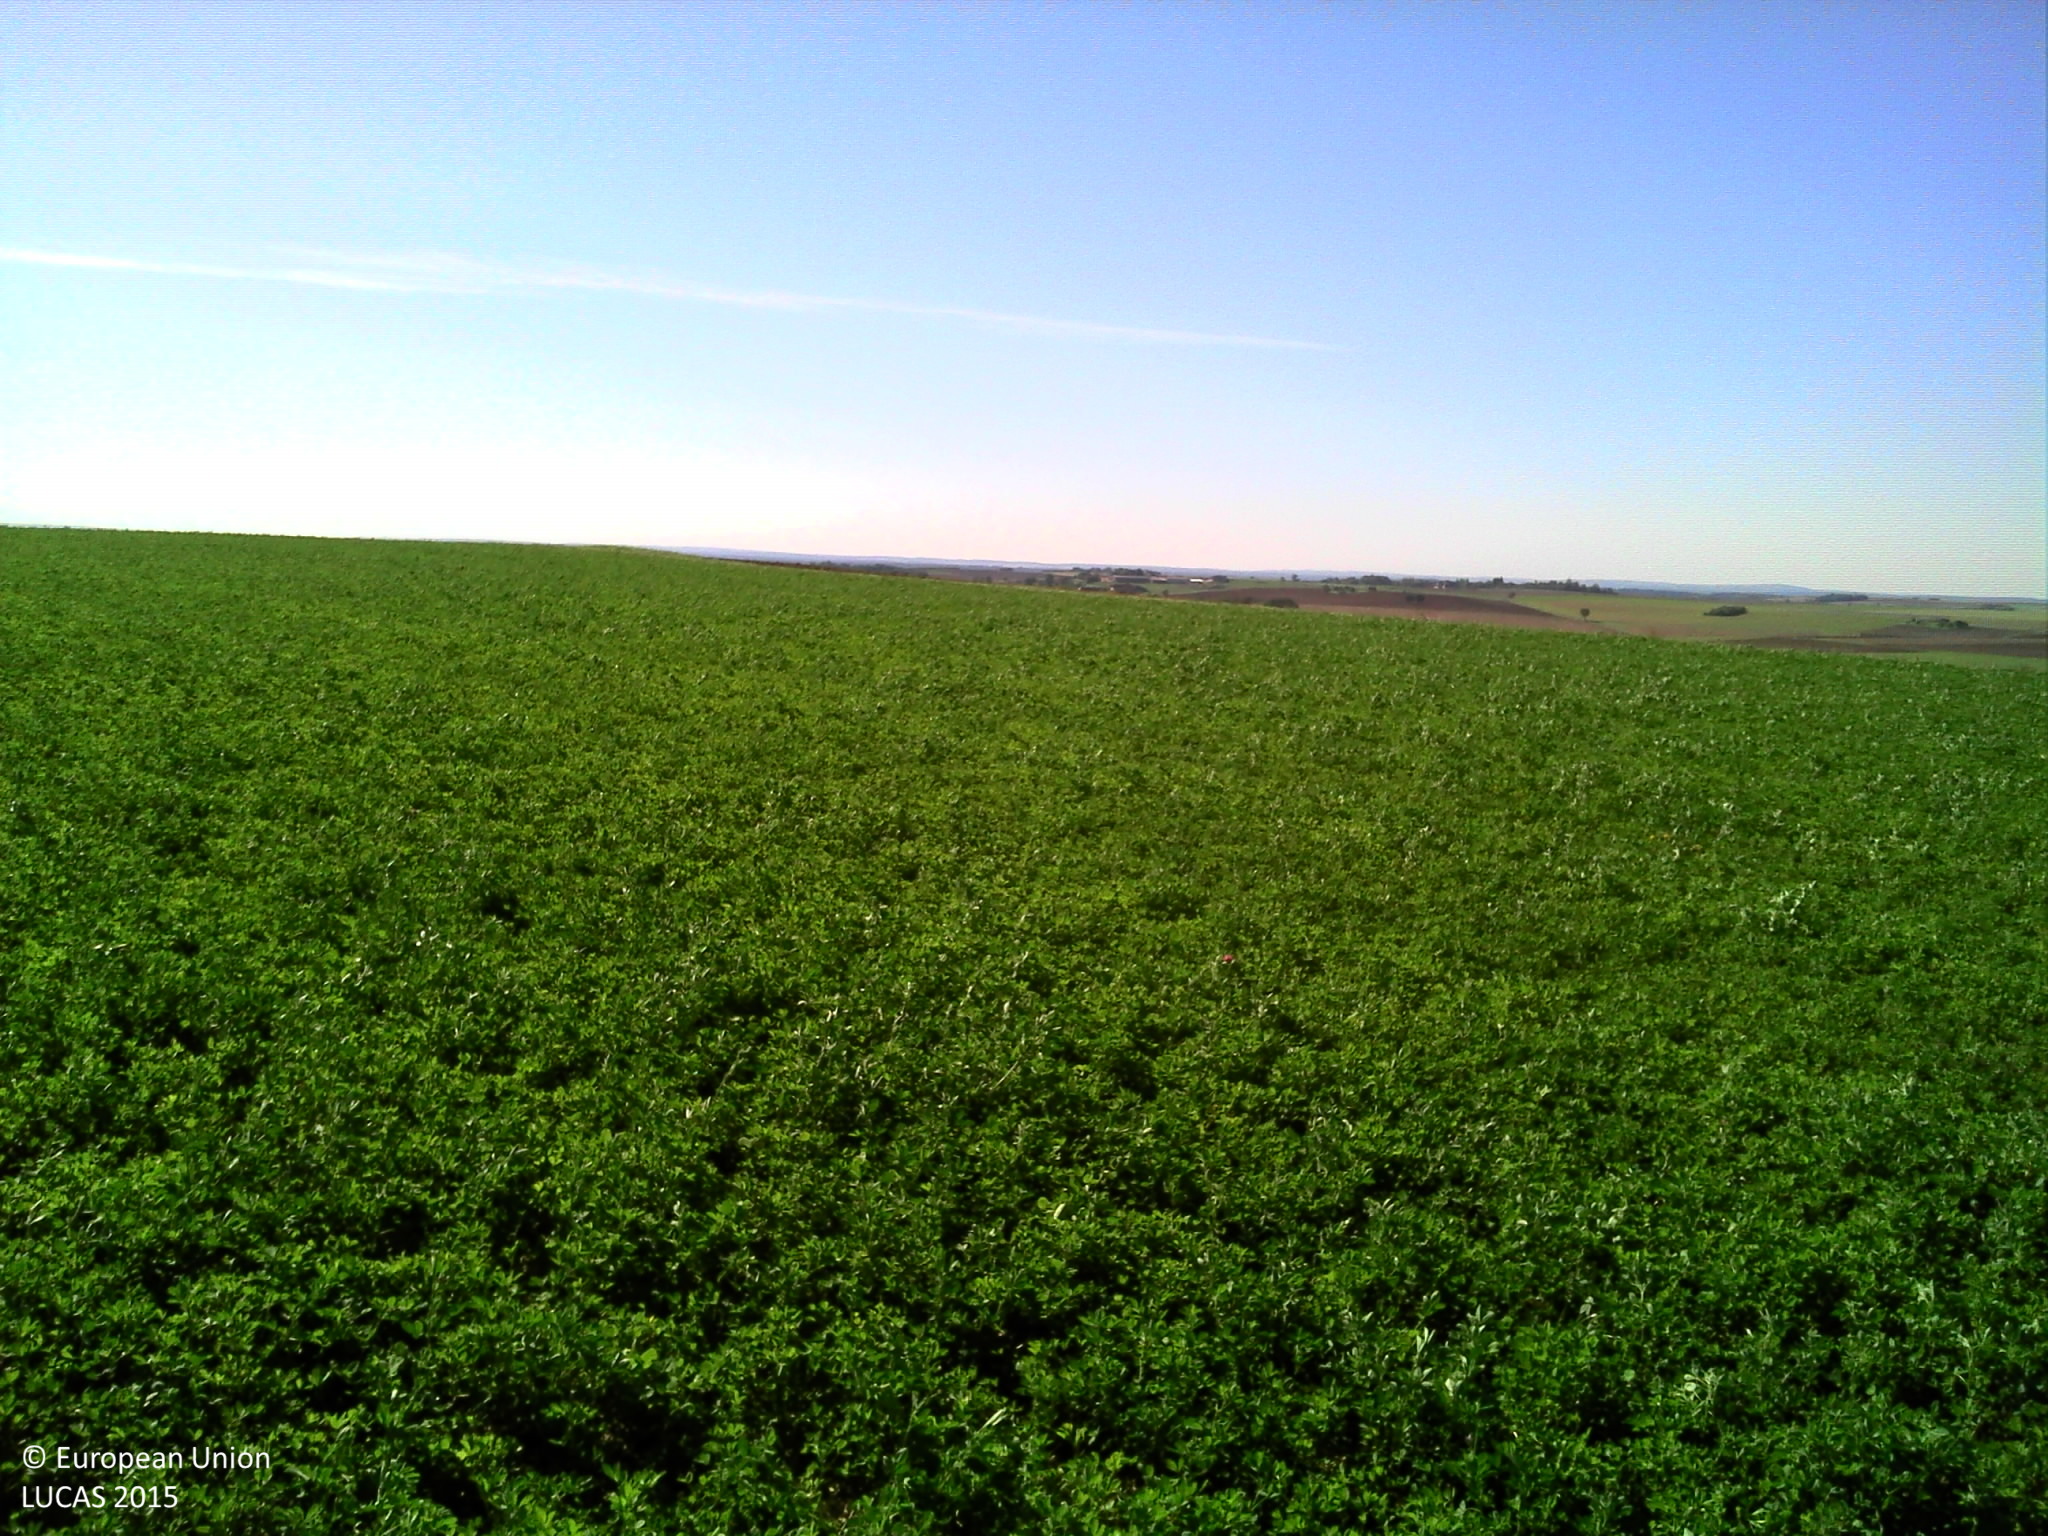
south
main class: Cropland
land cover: Lucerne
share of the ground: > 75 %
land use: Agriculture (excluding fallow land and kitchen gardens)
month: September
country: FR
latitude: 48.1079
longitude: 3.8852
